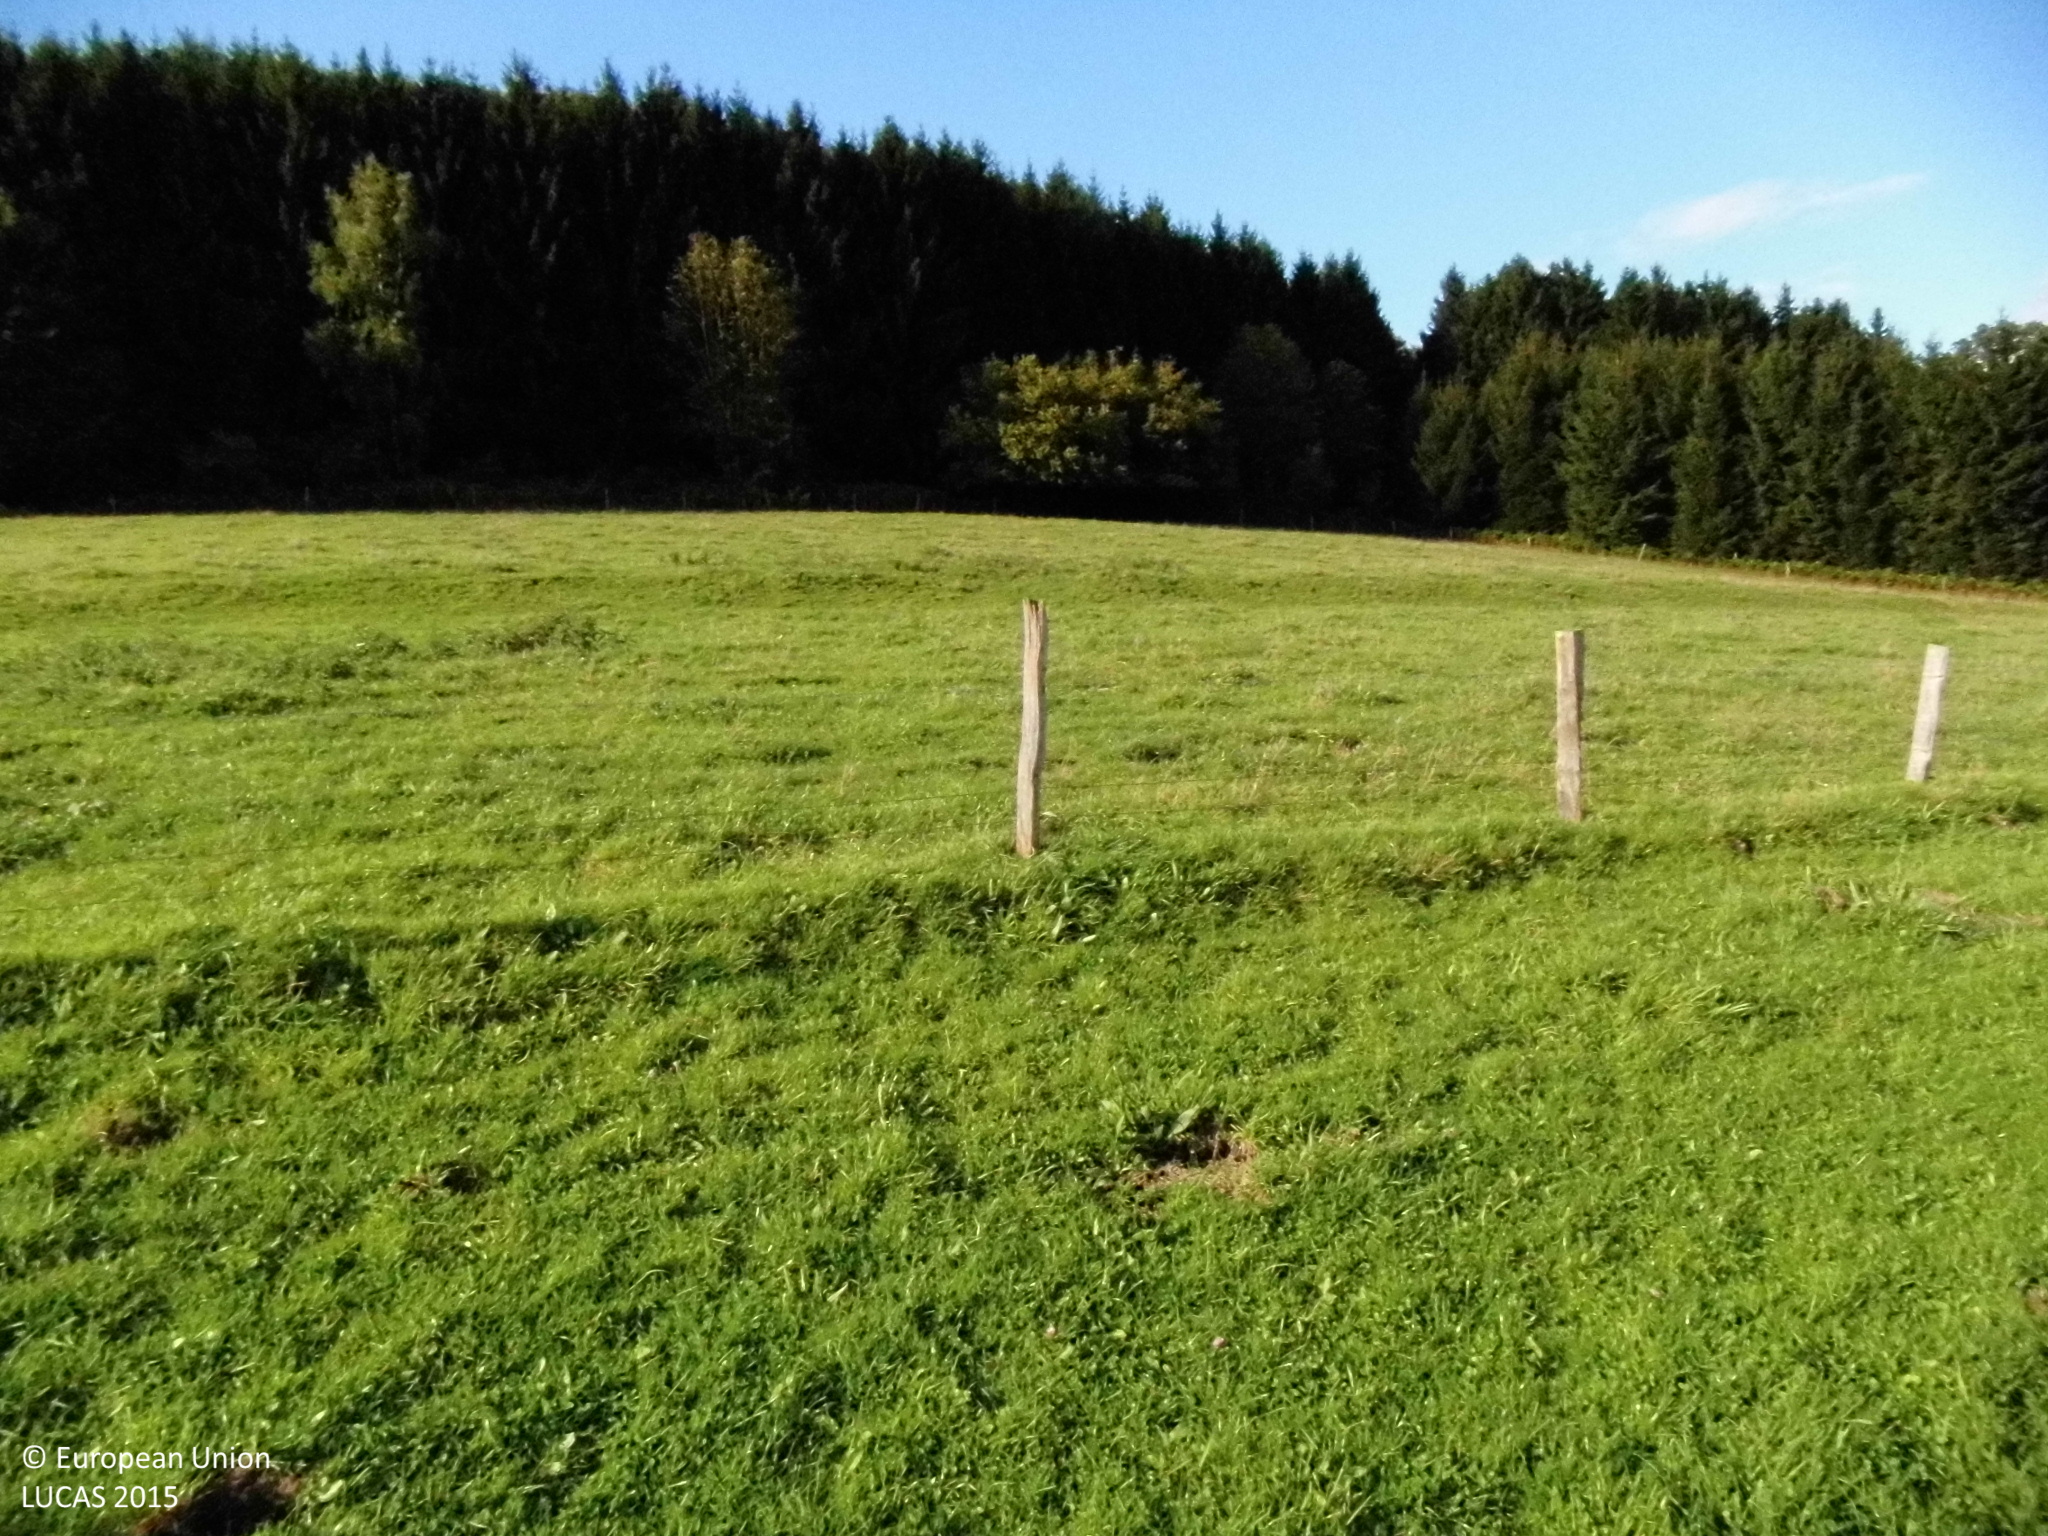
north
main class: Grassland
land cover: Grassland without tree/shrub cover
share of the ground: > 75 %
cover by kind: herbaceous plants 100 %
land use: Agriculture (excluding fallow land and kitchen gardens)
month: September
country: DE
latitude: 51.0551
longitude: 7.4465
